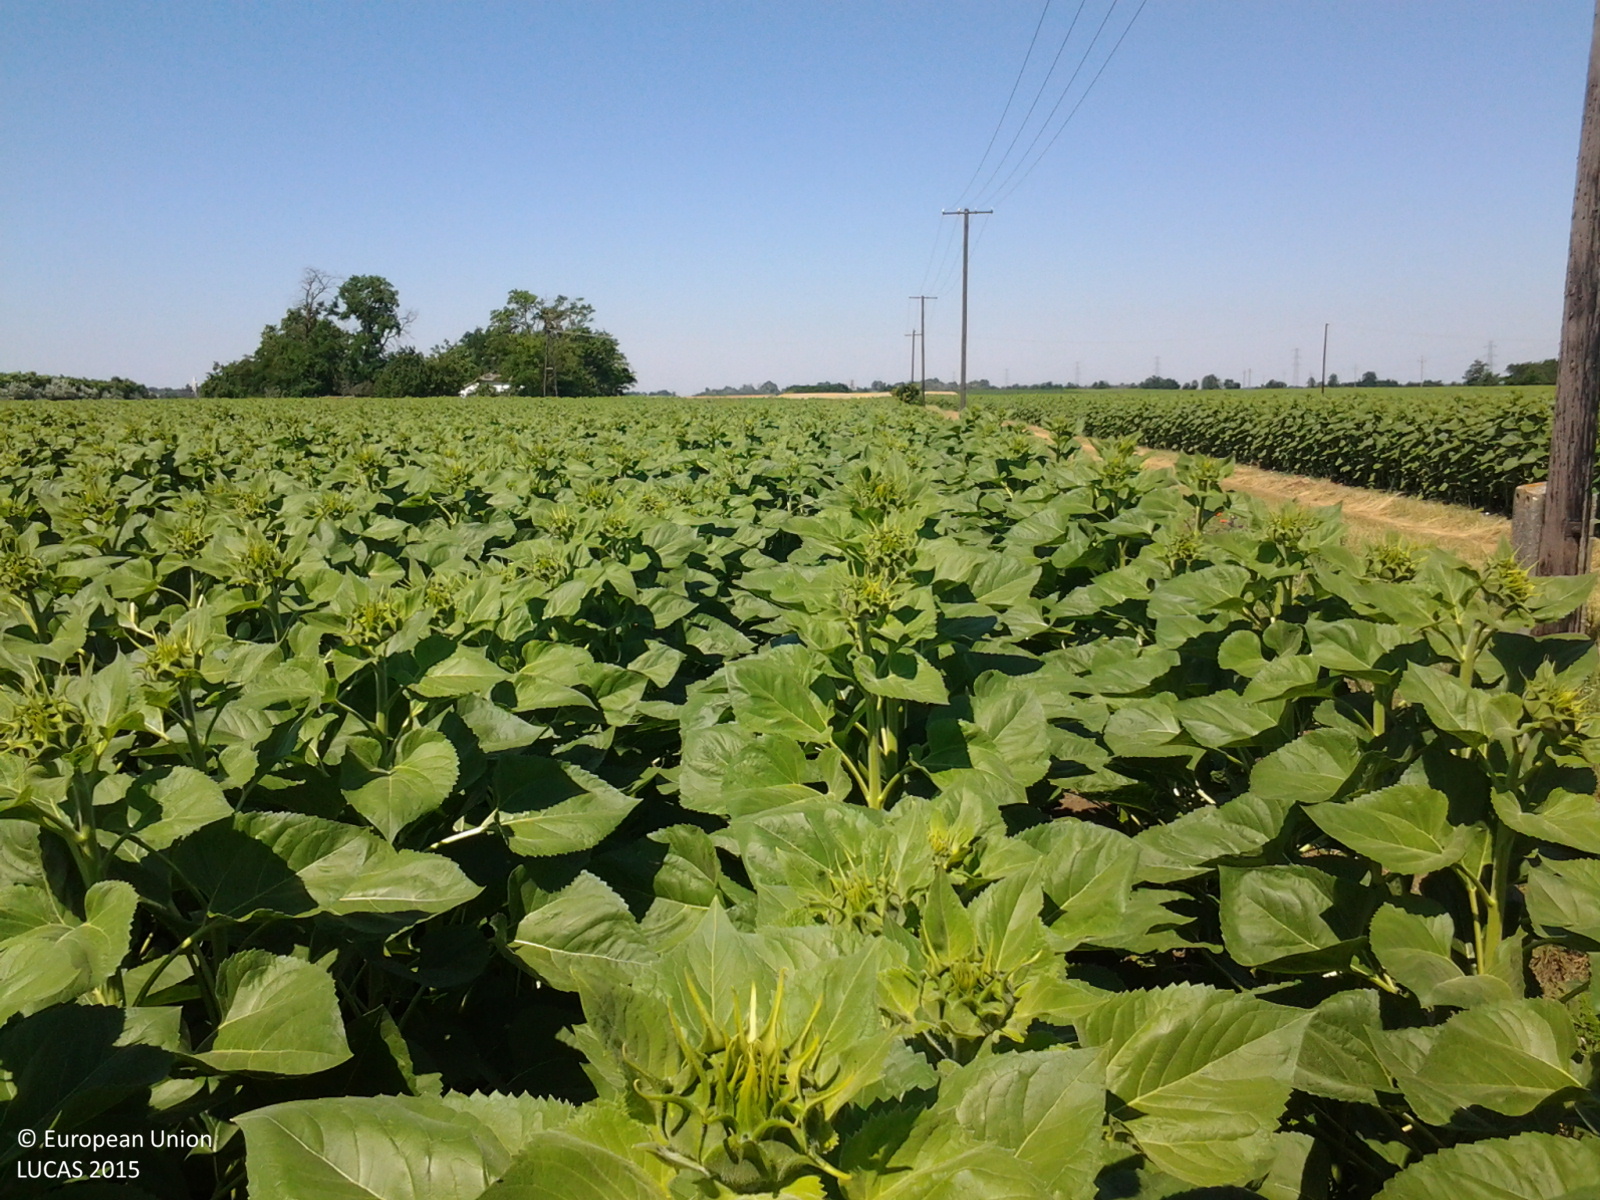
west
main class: Cropland
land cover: Sunflower
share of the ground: > 75 %
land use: Agriculture (excluding fallow land and kitchen gardens)
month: June
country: HU
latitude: 46.5997
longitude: 20.6414
